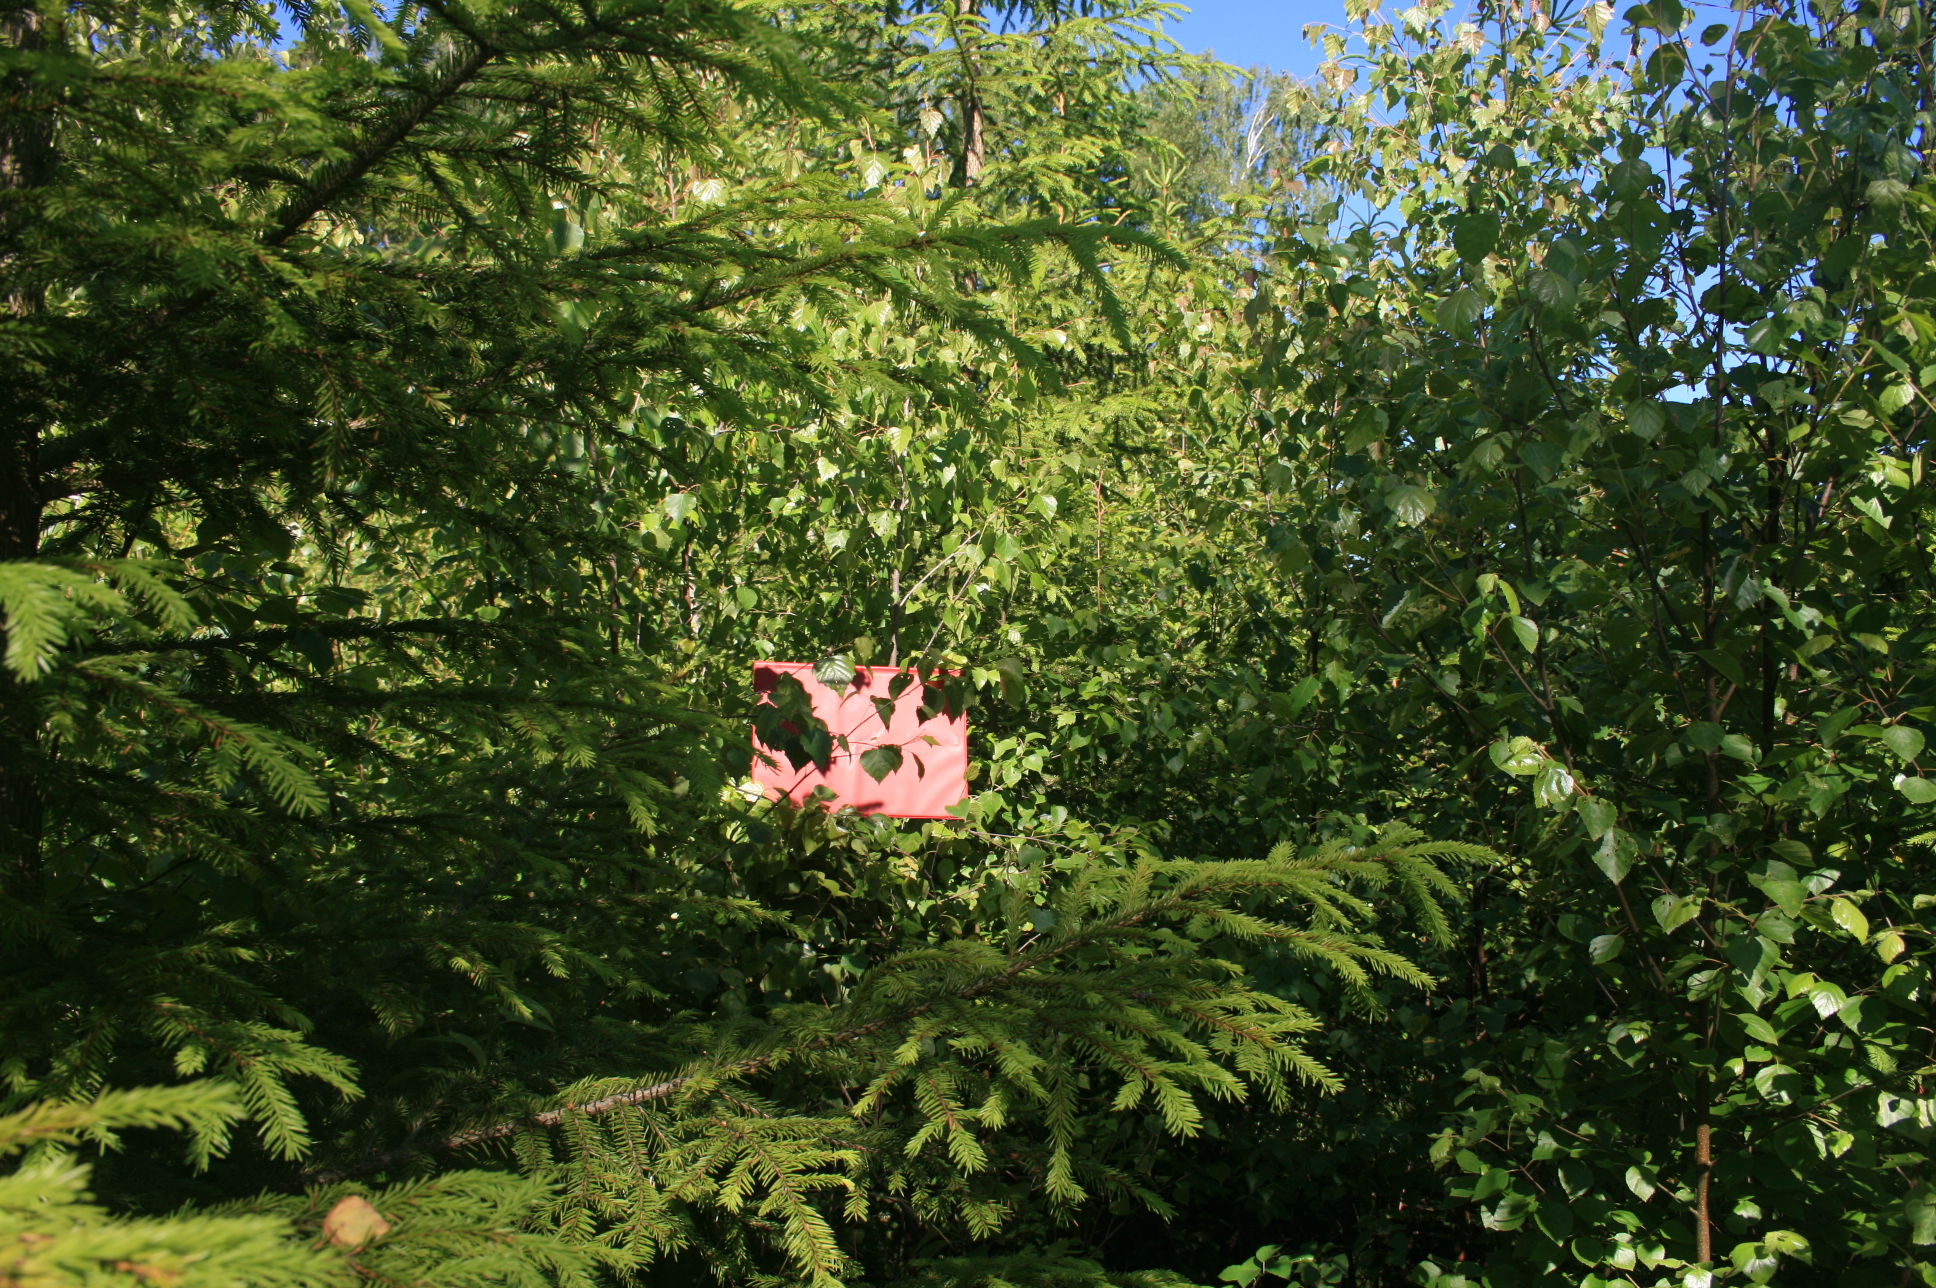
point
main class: Woodland
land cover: Spruce dominated mixed woodland
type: hemiboreal forest and nemoral coniferous forest and mixed broadleaved-coniferous forest
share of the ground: > 75 %
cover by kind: broadleaved forest trees 55 %, coniferous forest trees 45 %
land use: Forestry
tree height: < 5 m
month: June
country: LT
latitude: 55.4441
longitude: 22.1489
